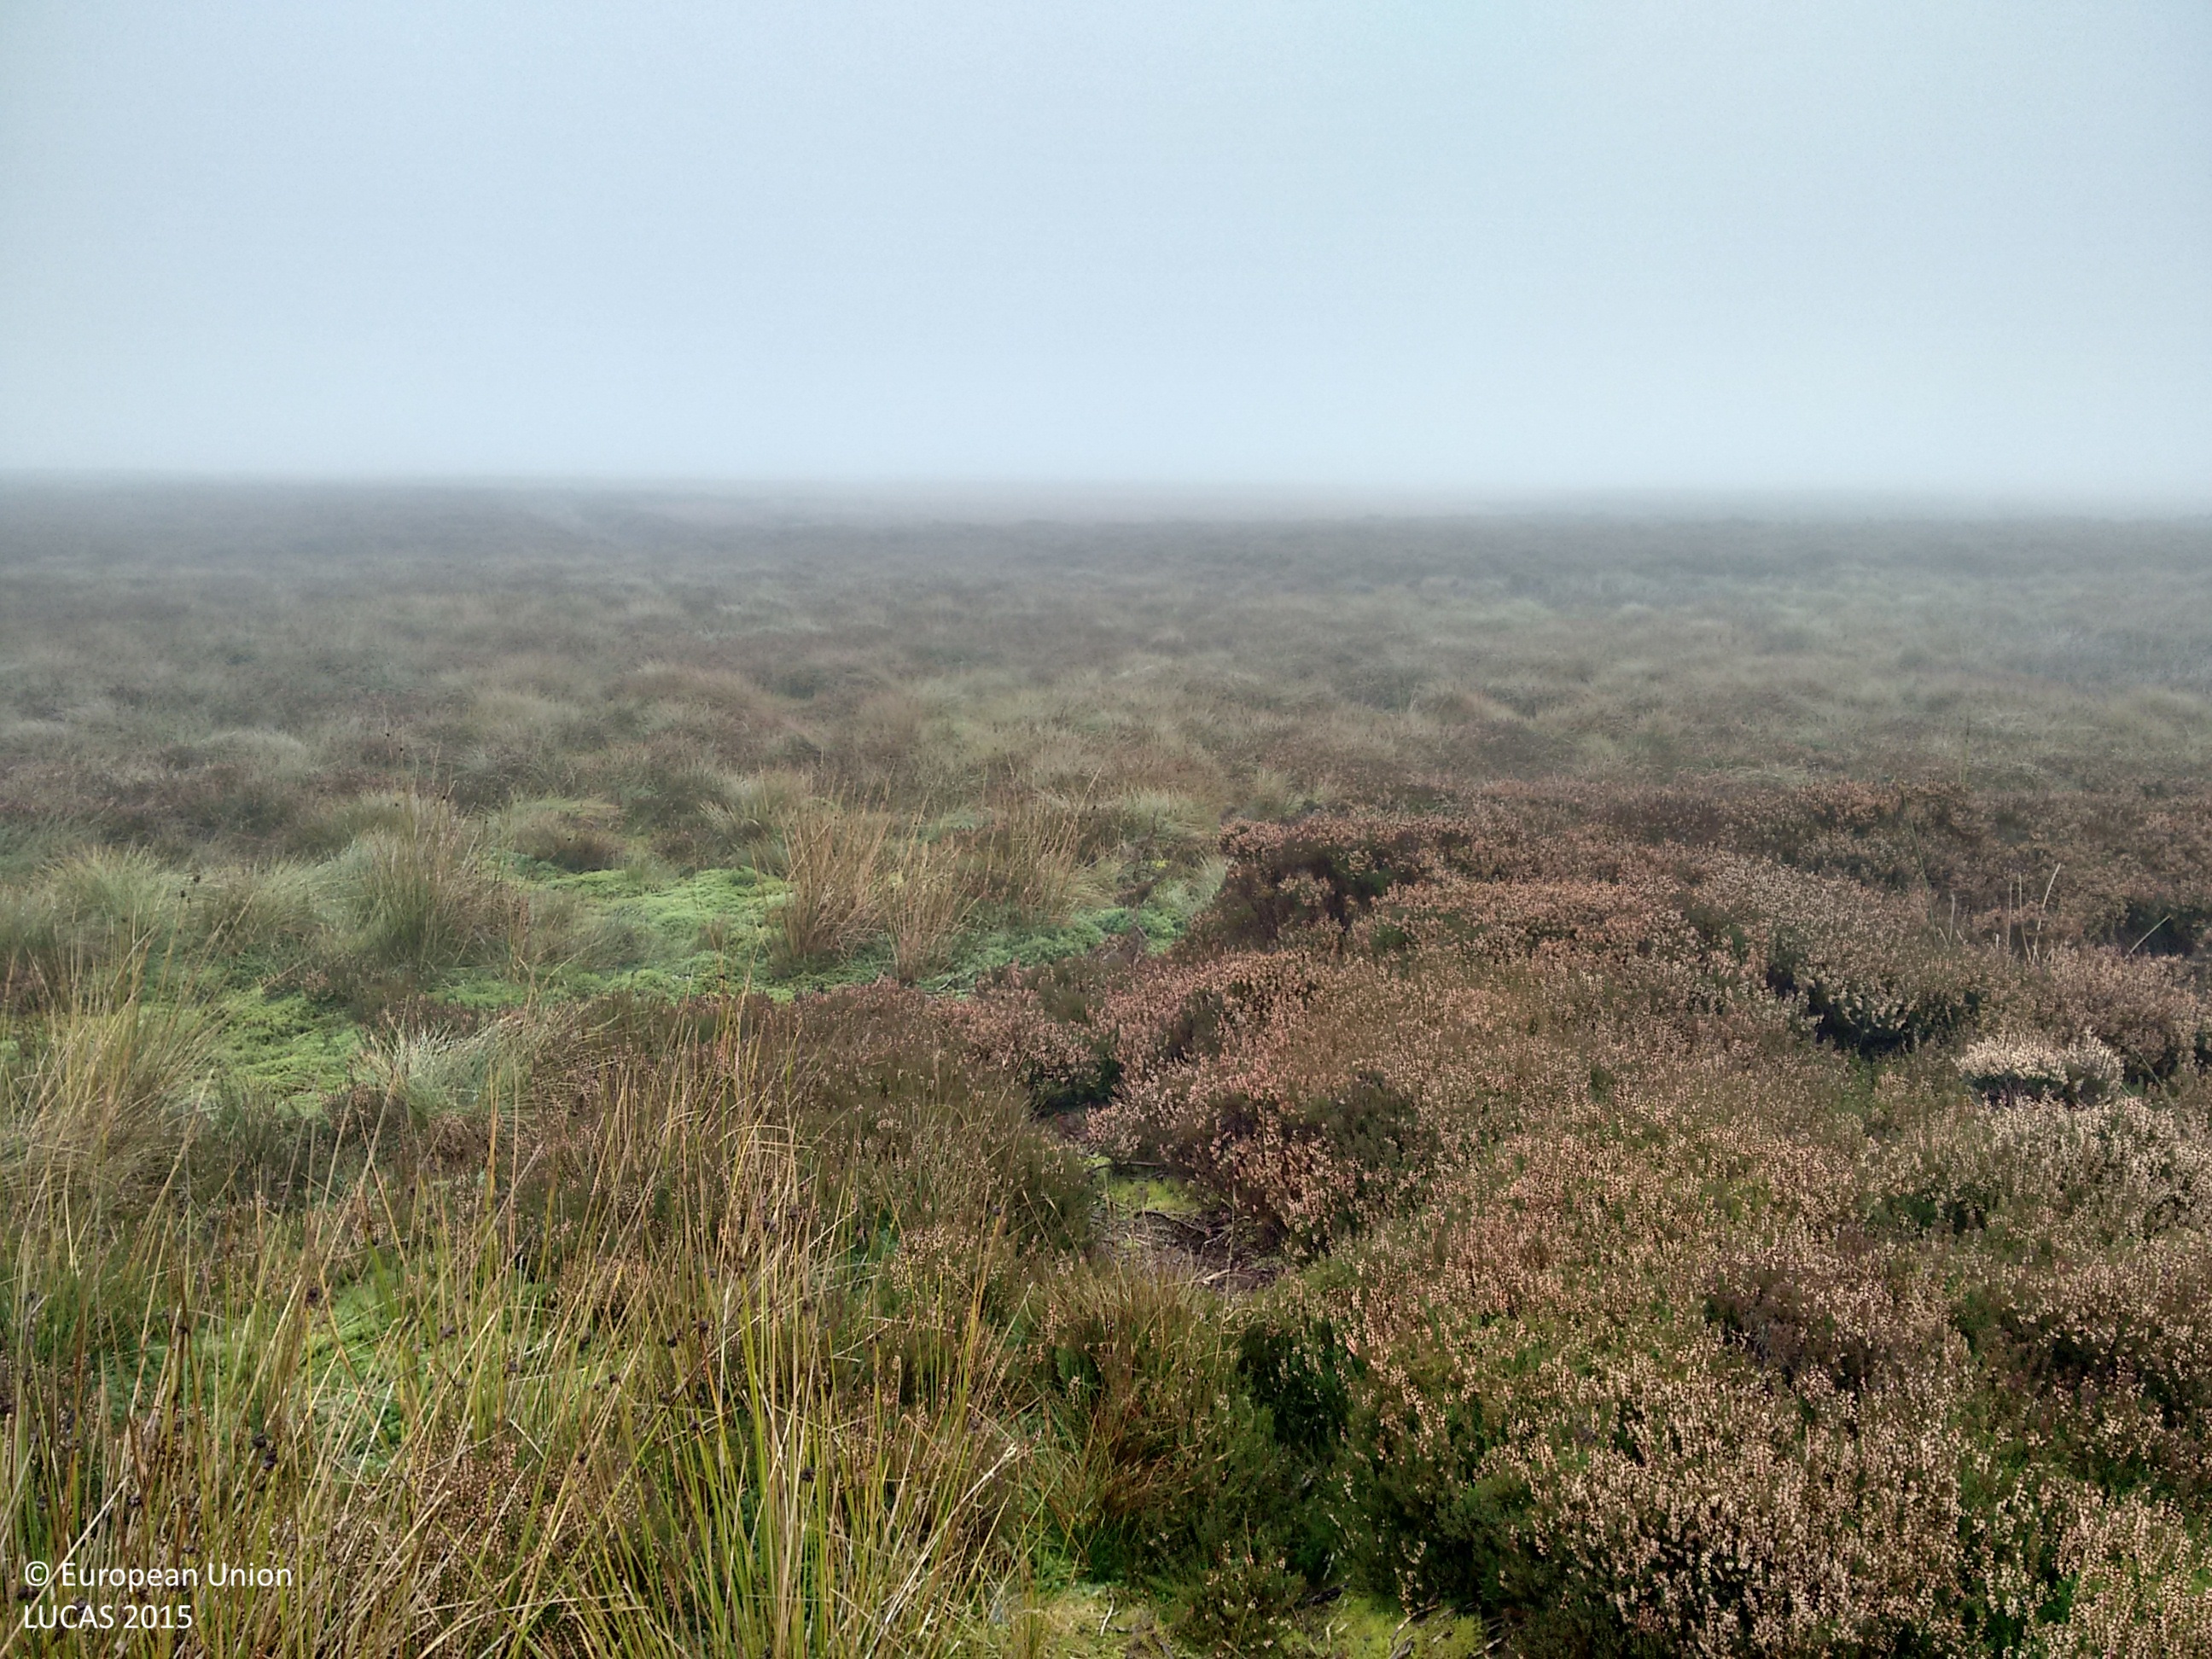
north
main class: Shrubland
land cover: Shrubland without tree cover
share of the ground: > 75 %
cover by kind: shrubs 80 %, herbaceous plants 20 %
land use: Semi-natural and natural areas not in use
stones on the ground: < 10 %
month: October
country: GB
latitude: 54.4654
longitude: -2.1071
